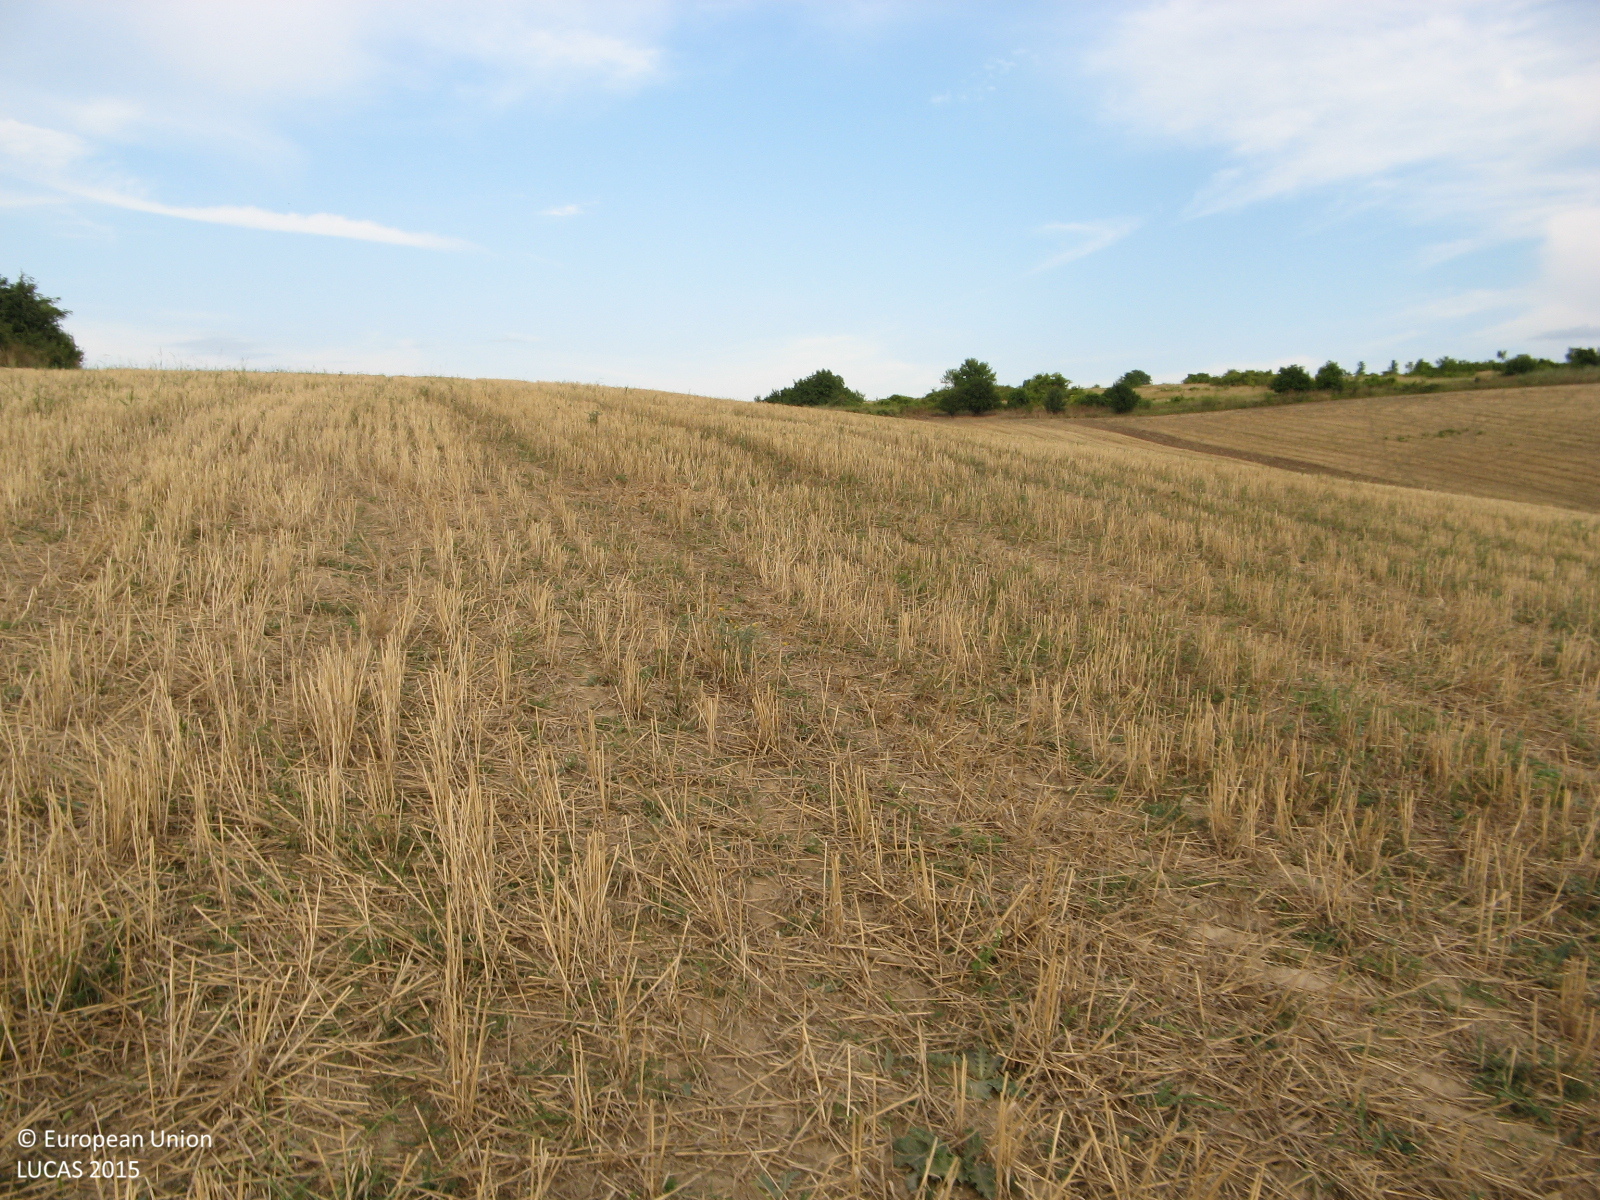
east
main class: Cropland
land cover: Common wheat
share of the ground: 25 - 50 %
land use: Agriculture (excluding fallow land and kitchen gardens)
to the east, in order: Common wheat
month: August
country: BG
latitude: 43.6214
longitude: 25.7143
